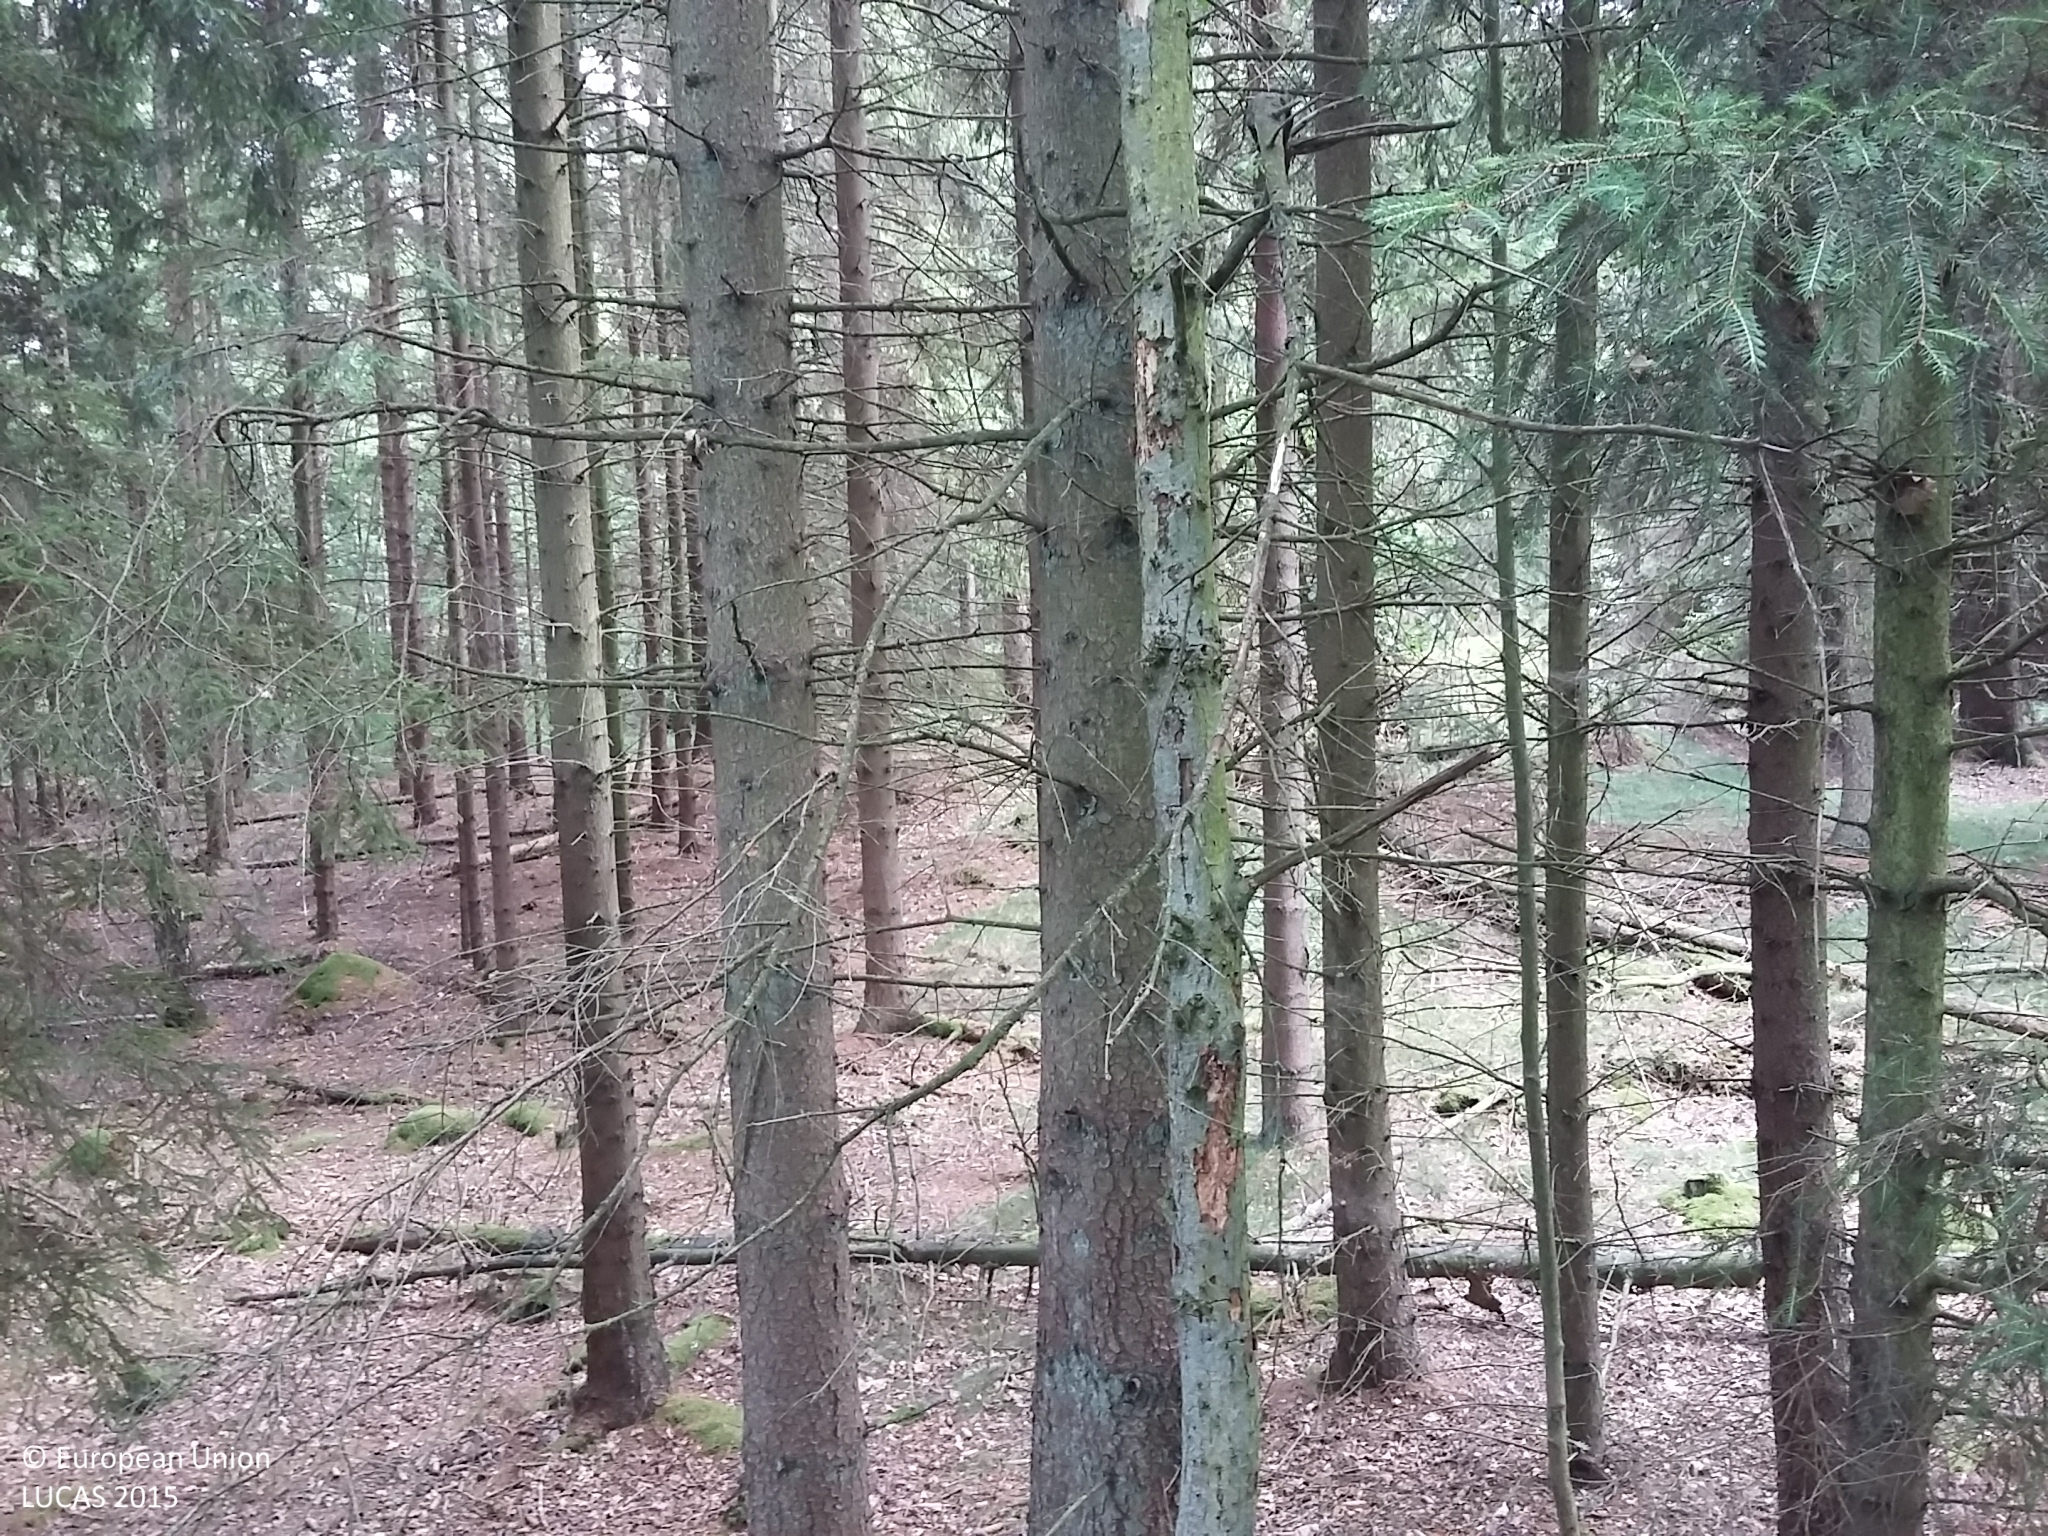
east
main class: Woodland
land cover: Other mixed woodland
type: hemiboreal forest and nemoral coniferous forest and mixed broadleaved-coniferous forest
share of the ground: > 75 %
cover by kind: coniferous forest trees 60 %, broadleaved forest trees 25 %, herbaceous plants 10 %, lichens and mosses 5 %
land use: Semi-natural and natural areas not in use
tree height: > 5 m
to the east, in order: Other mixed woodland; Spruce dominated coniferous woodland; Broadleaved woodland; Other mixed woodland; Broadleaved woodland; Other mixed woodland; Broadleaved woodland
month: August
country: DK
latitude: 55.2529
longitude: 14.7667
